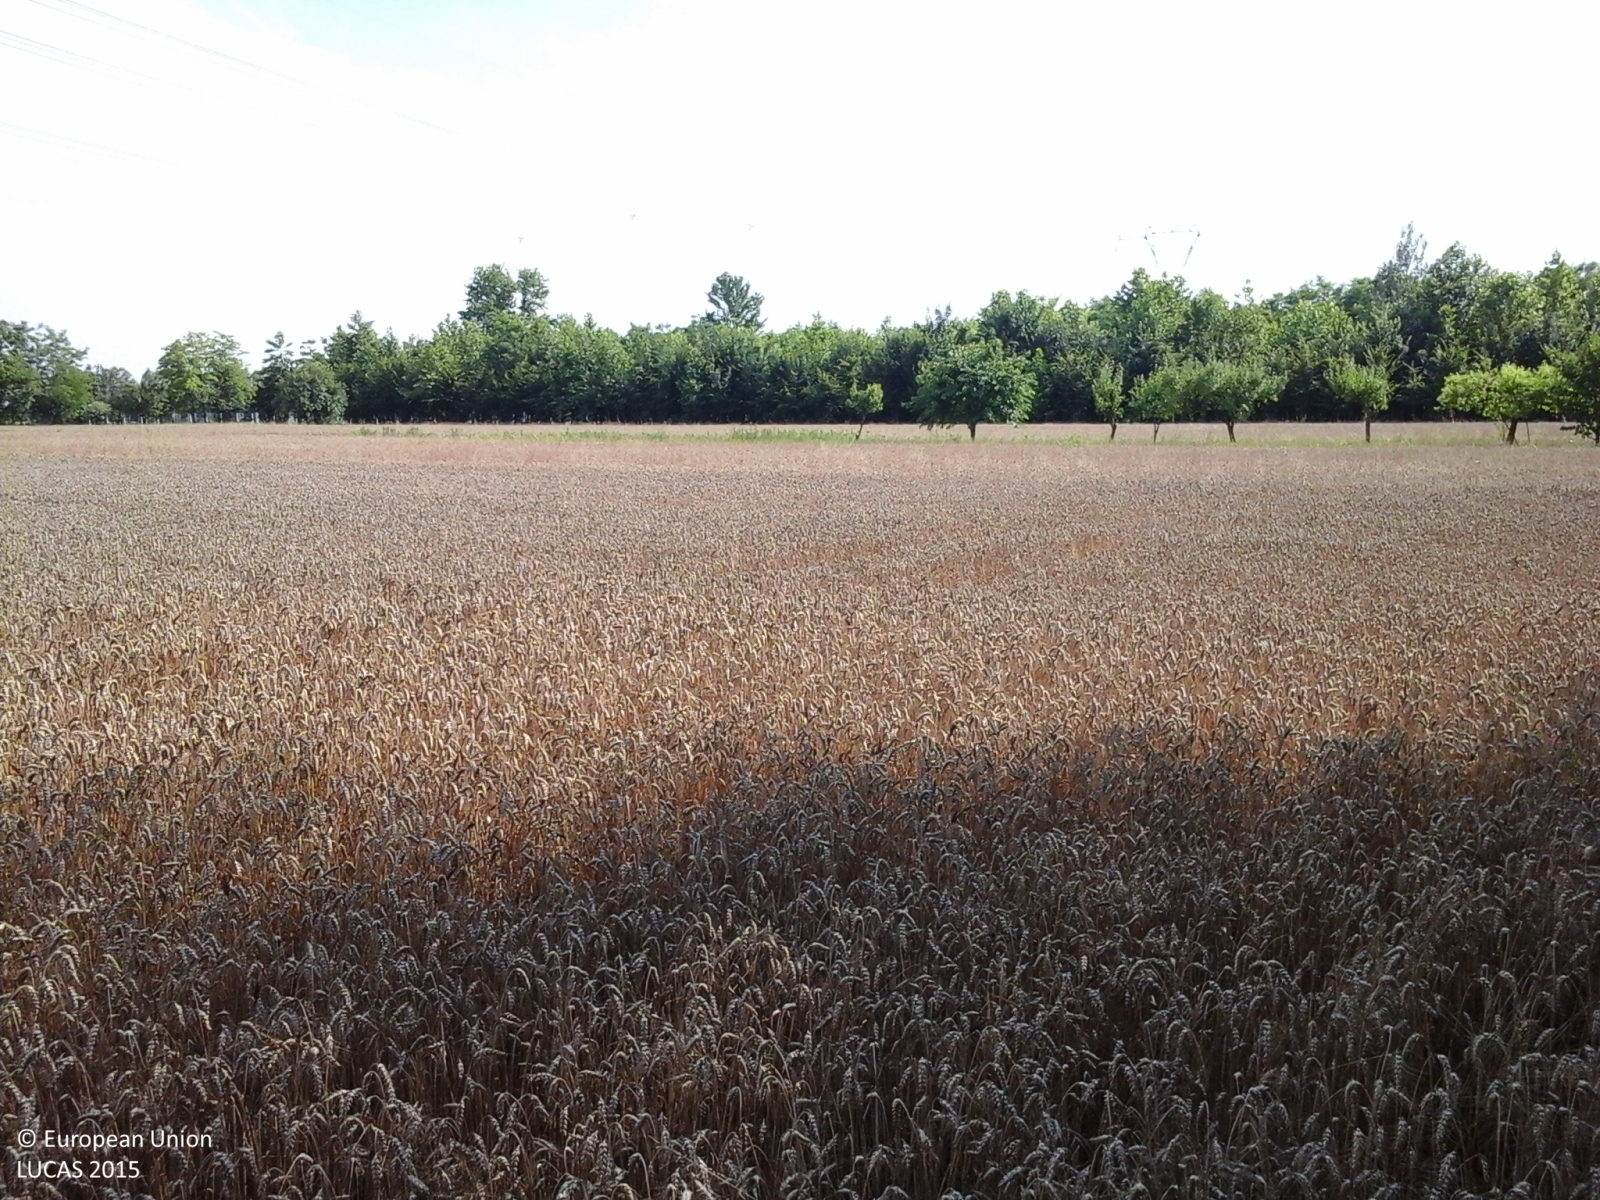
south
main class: Cropland
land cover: Common wheat
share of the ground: > 75 %
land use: Agriculture (excluding fallow land and kitchen gardens)
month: June
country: IT
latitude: 45.8910
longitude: 12.4324
